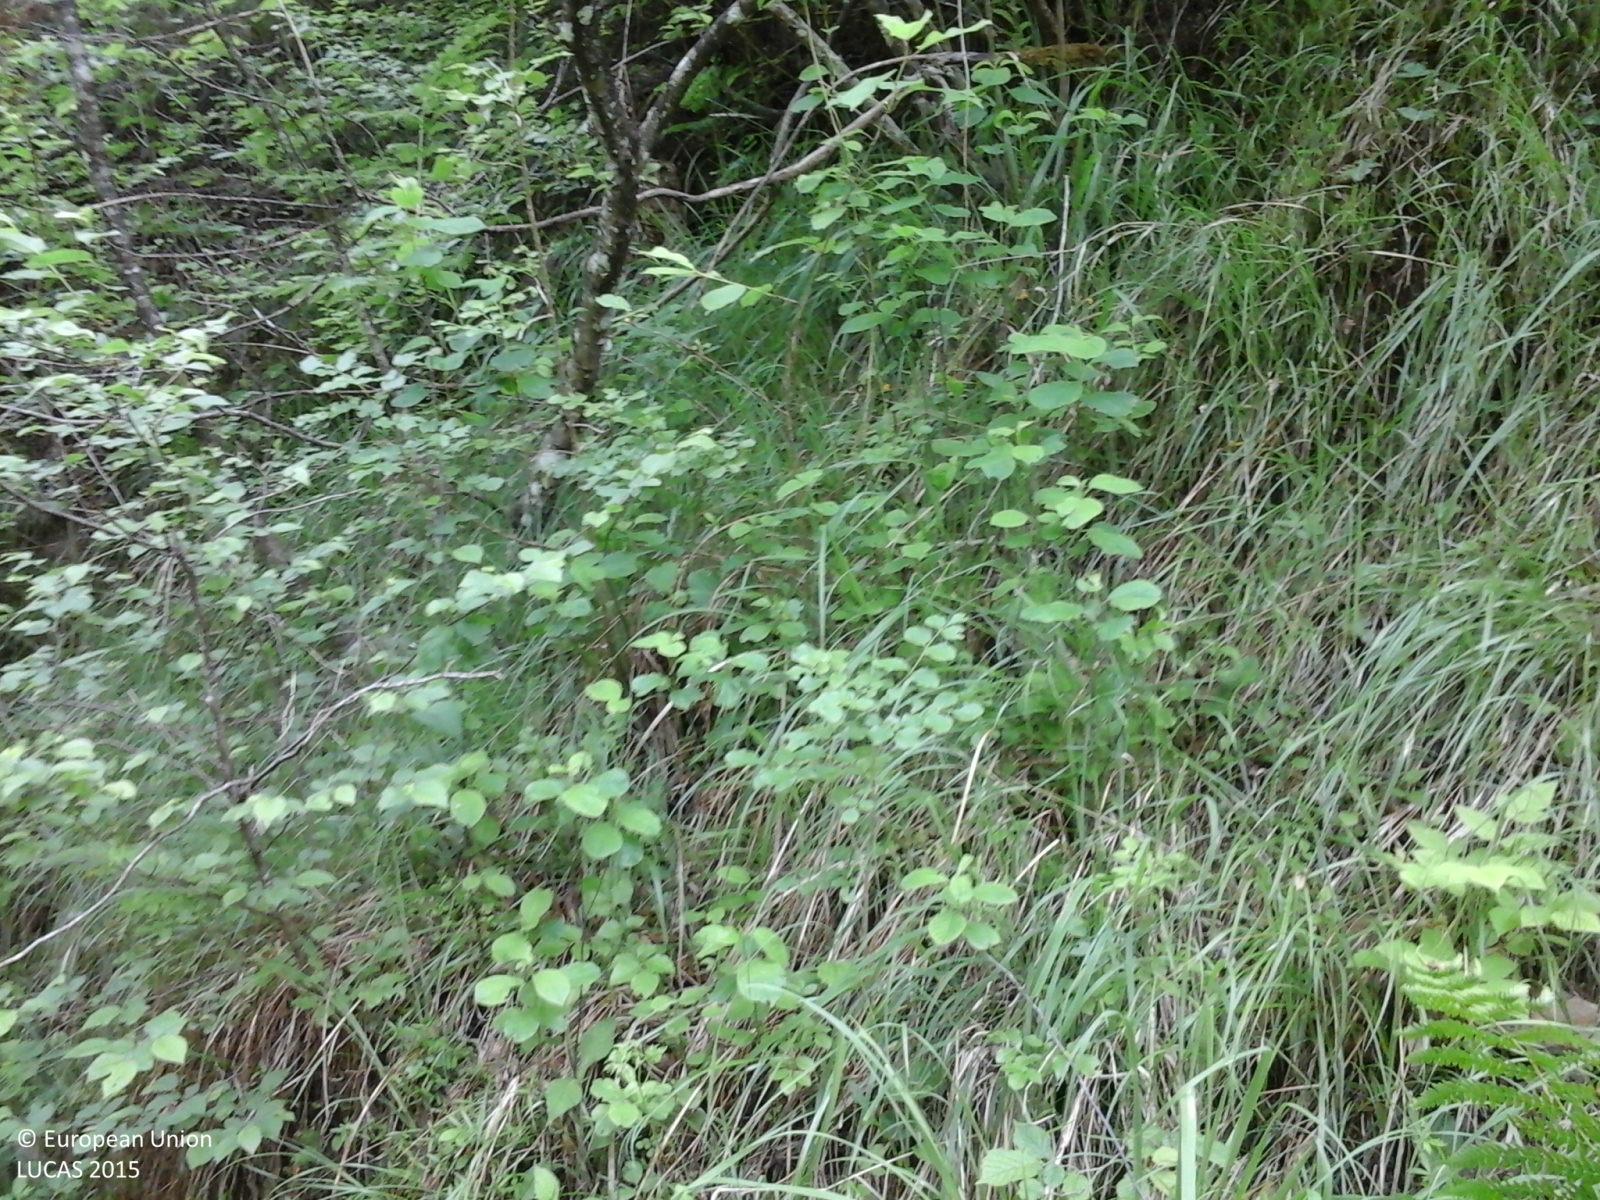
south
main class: Woodland
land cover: Other mixed woodland
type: mesophytic deciduous forest
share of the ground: > 75 %
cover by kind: broadleaved forest trees 75 %, coniferous forest trees 25 %
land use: Semi-natural and natural areas not in use
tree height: > 5 m
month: June
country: IT
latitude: 46.0936
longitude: 12.2348
